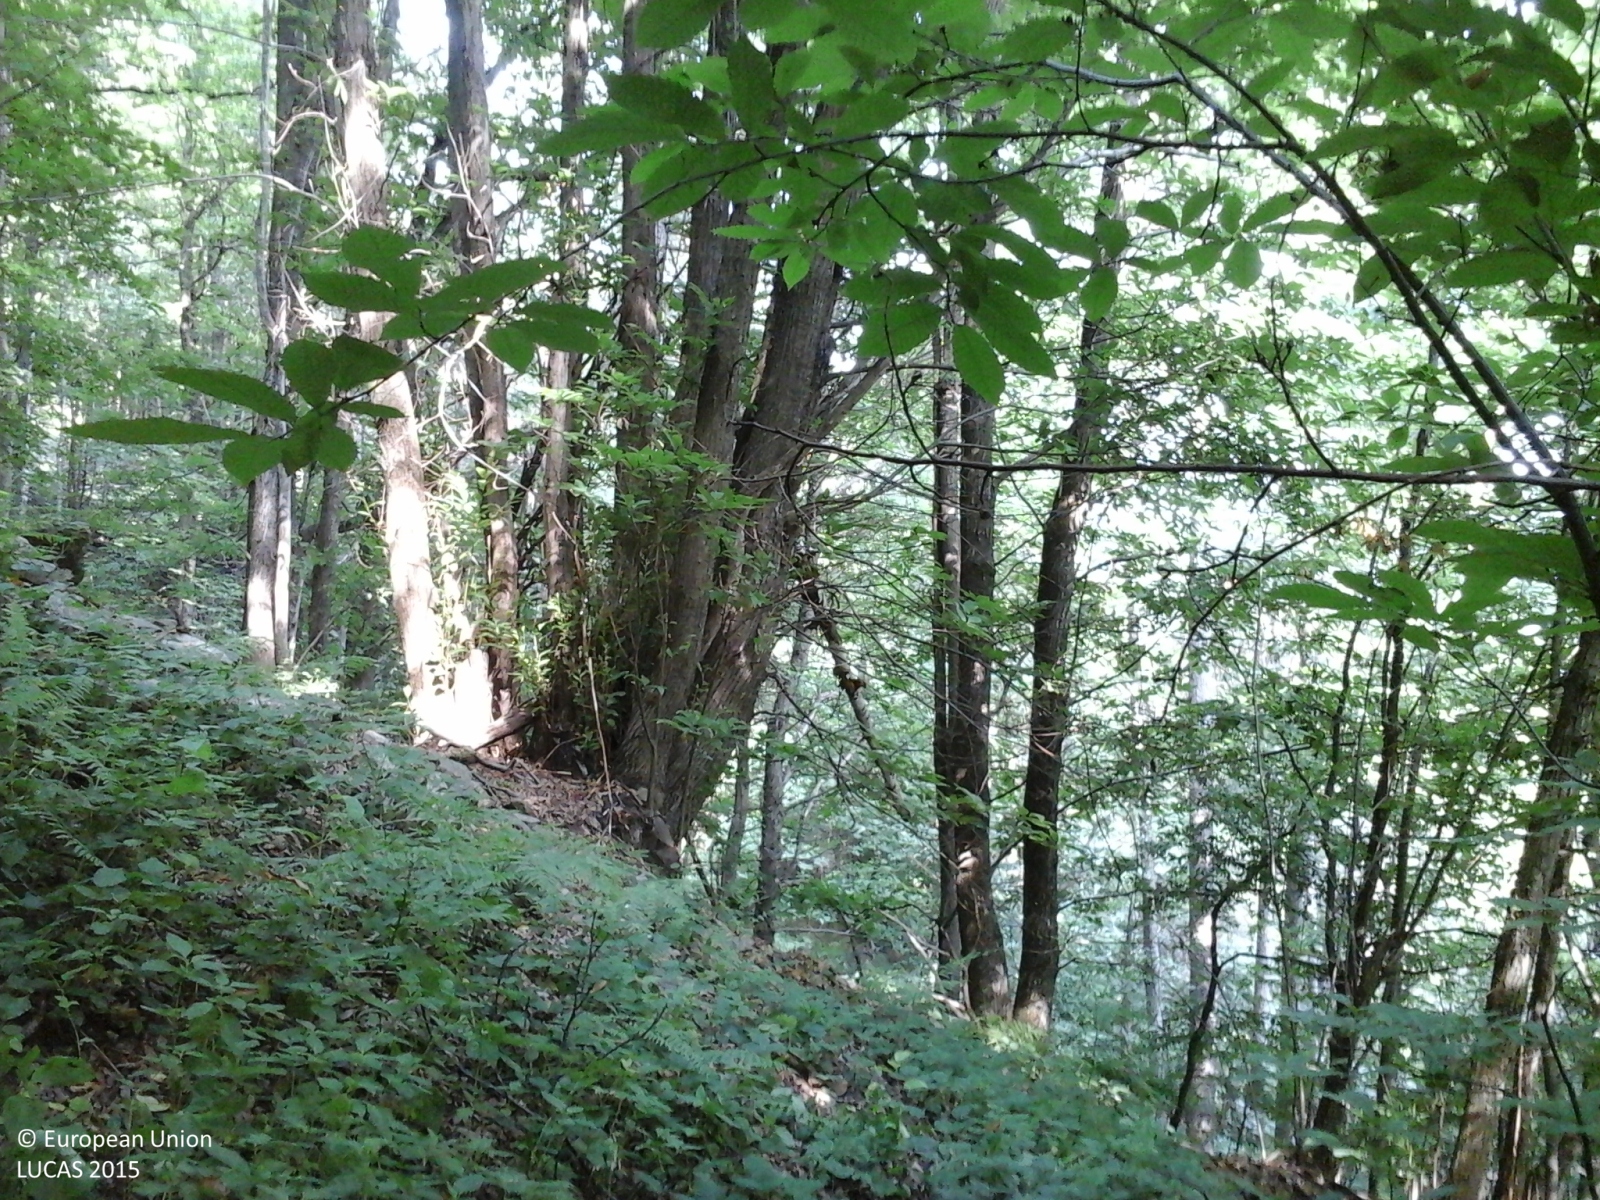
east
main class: Woodland
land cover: Broadleaved woodland
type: thermophilous deciduous forest
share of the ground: > 75 %
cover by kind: broadleaved forest trees 90 %, shrubs 10 %
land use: Forestry
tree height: > 5 m
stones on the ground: < 10 %
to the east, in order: Broadleaved woodland; Tracks; Broadleaved woodland; Inland fresh running water
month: June
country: IT
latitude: 44.5867
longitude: 7.3224
